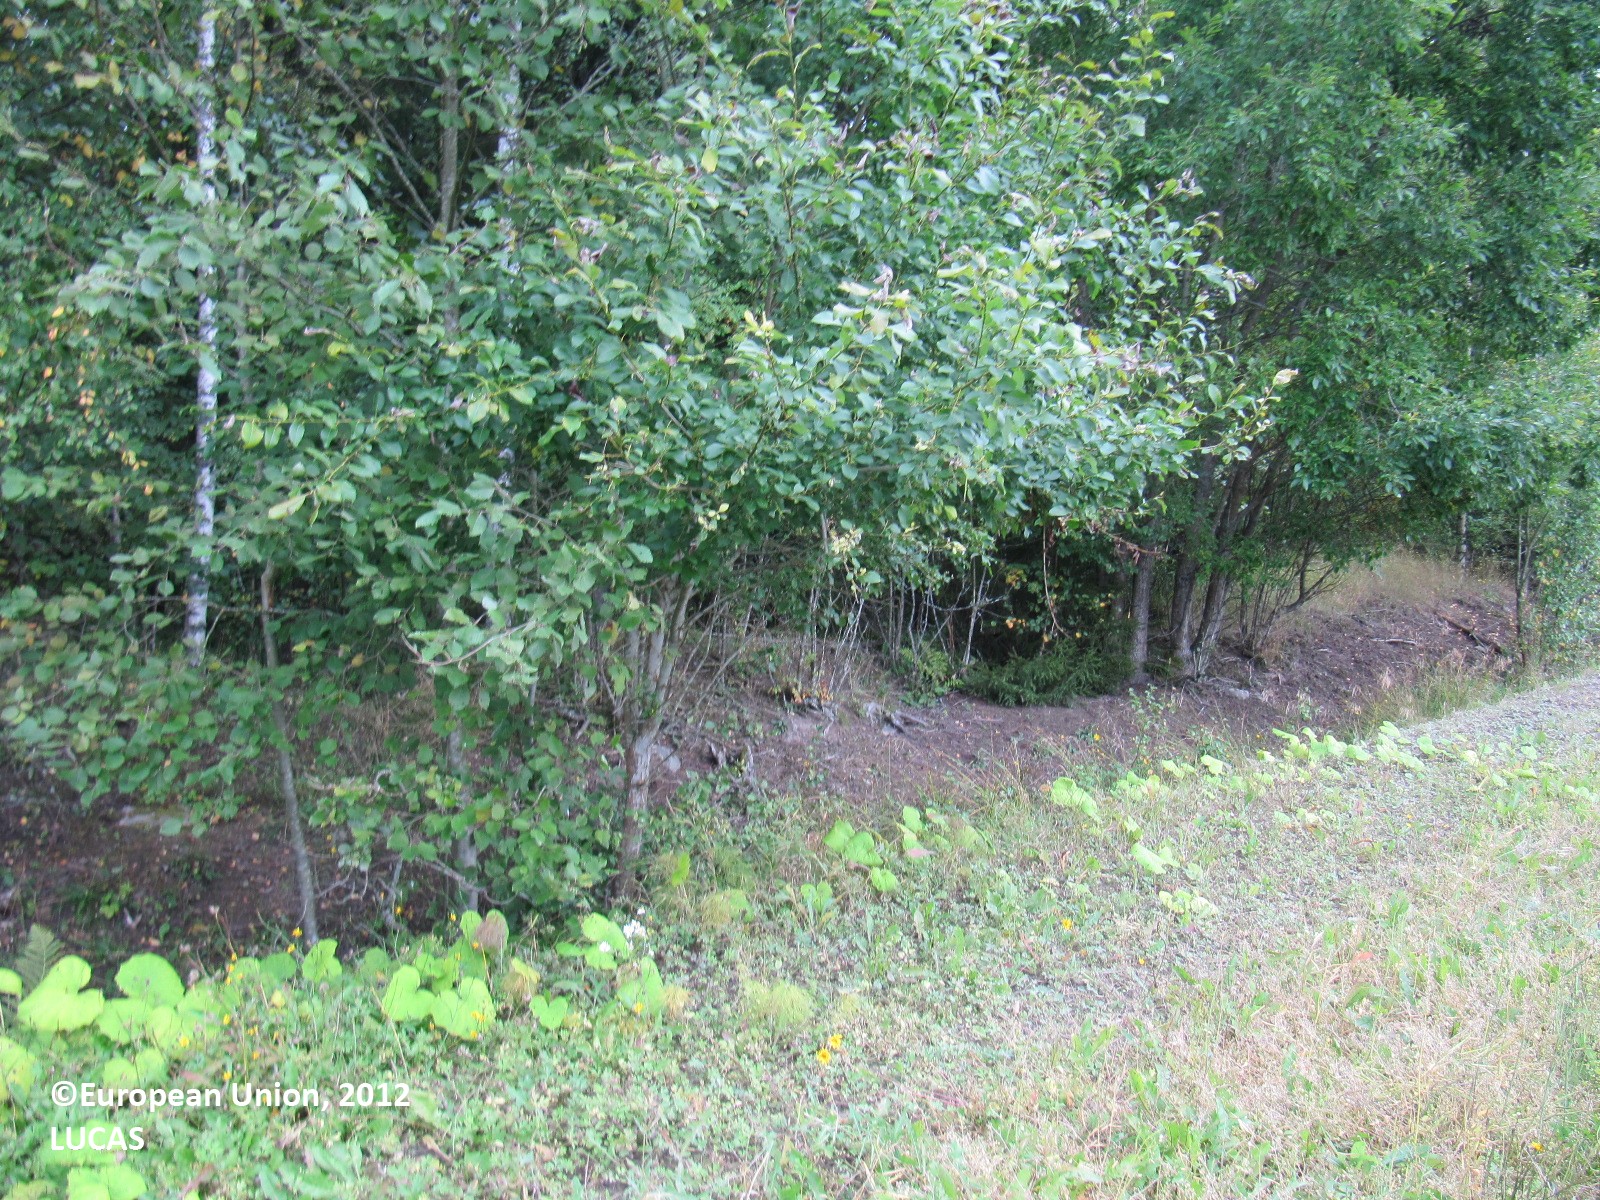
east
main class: Cropland
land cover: Rape and turnip rape
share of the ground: > 75 %
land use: Agriculture (excluding fallow land and kitchen gardens)
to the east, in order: Rape and turnip rape; Grass margins; Ditches and canals; Spruce dominated mixed woodland; Pine dominated mixed woodland
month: August
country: FI
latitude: 60.9381
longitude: 22.8997
